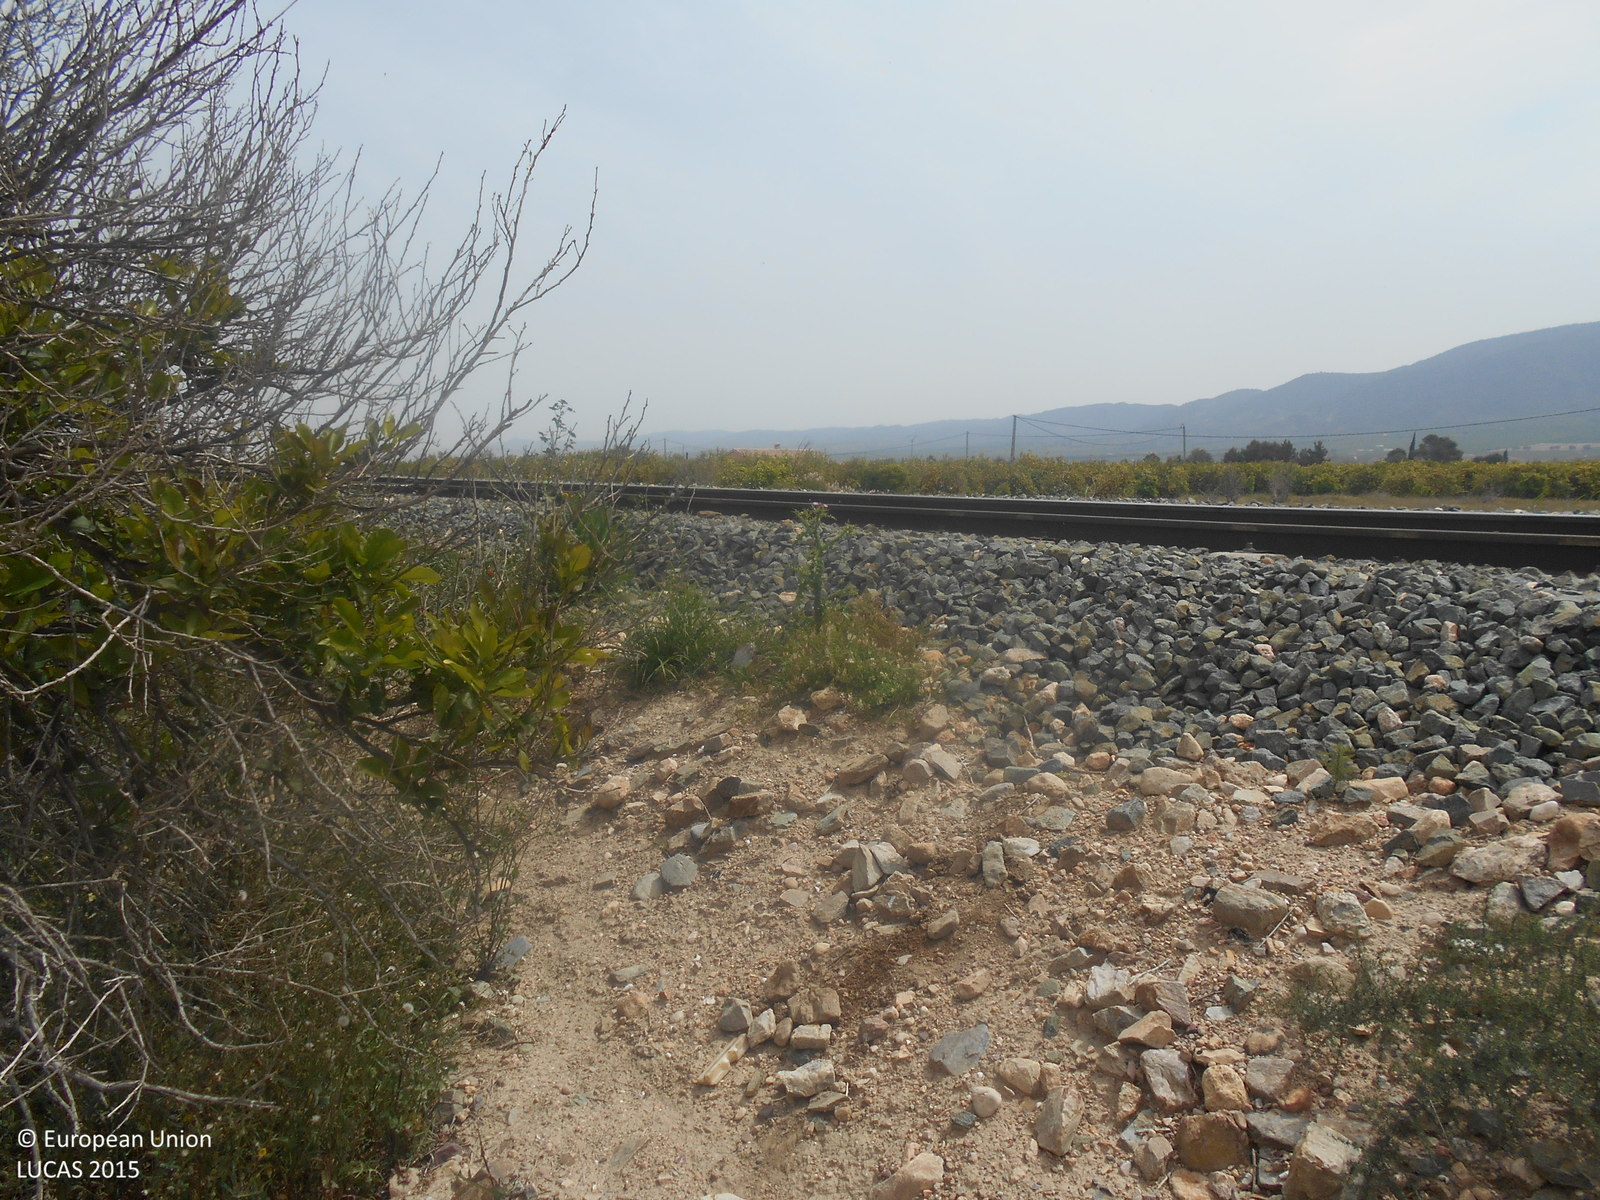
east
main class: Cropland
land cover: Olive groves
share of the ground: 10 - 25 %
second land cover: Other bare soil
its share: > 75 %
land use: Agriculture (excluding fallow land and kitchen gardens)
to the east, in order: Olive groves; Other bare soil; Rocks and stones; Railways; Rocks and stones; Grassland with sparse tree/shrub cover; Ditches and canals; Grassland without tree/shrub cover; Ditches and canals; Other citrus fruit; Ditches and canals; Other citrus fruit; Tracks; Other citrus fruit; Tracks; Electric lines; Ditches and canals; Other citrus fruit; Ditches and canals; Other citrus fruit; Dry stone walls; Artificial constructions in urban areas; Dry stone walls; Tracks; Ditches and canals; Other citrus fruit
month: April
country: ES
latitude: 37.8897
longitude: -1.3432
